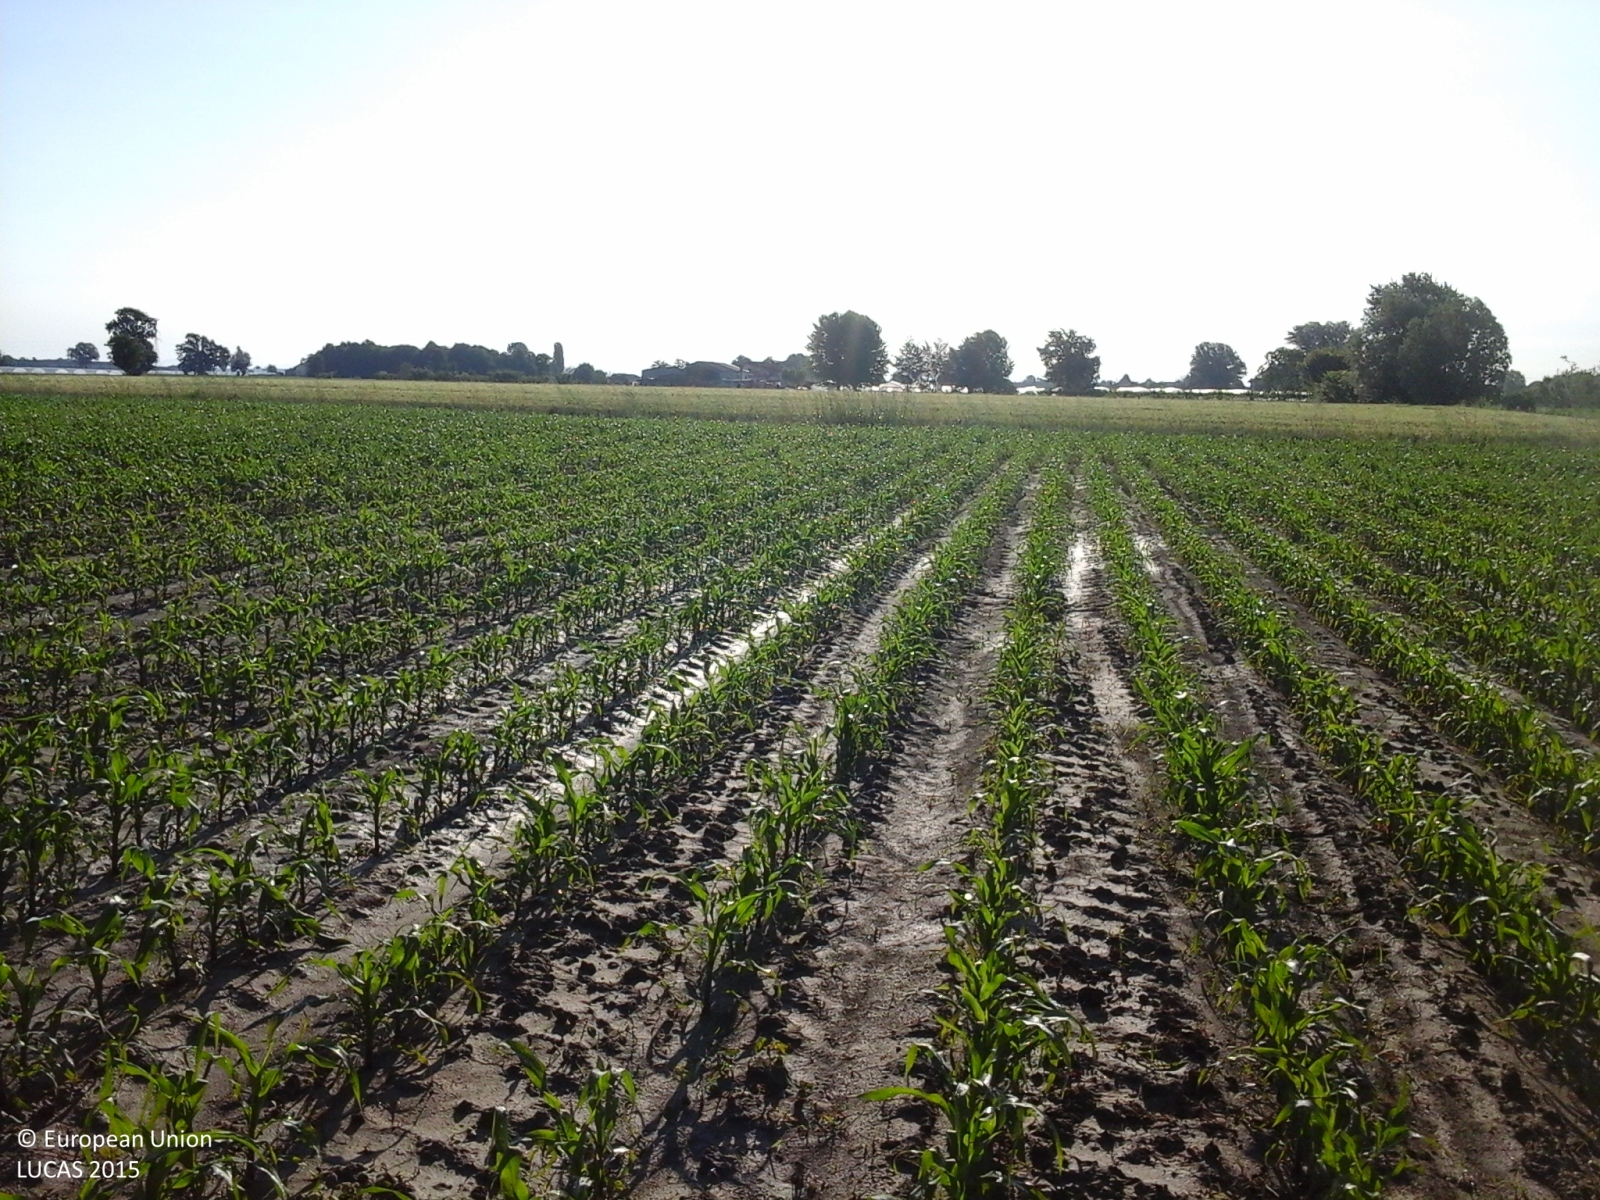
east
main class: Cropland
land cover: Maize
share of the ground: 25 - 50 %
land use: Agriculture (excluding fallow land and kitchen gardens)
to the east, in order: Maize; Ditches and canals; Common wheat; Ditches and canals; Maize; Grassland without tree/shrub cover; Ditches and canals; Single bushes/trees; Maize
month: May
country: IT
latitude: 45.0646
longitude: 11.2296
